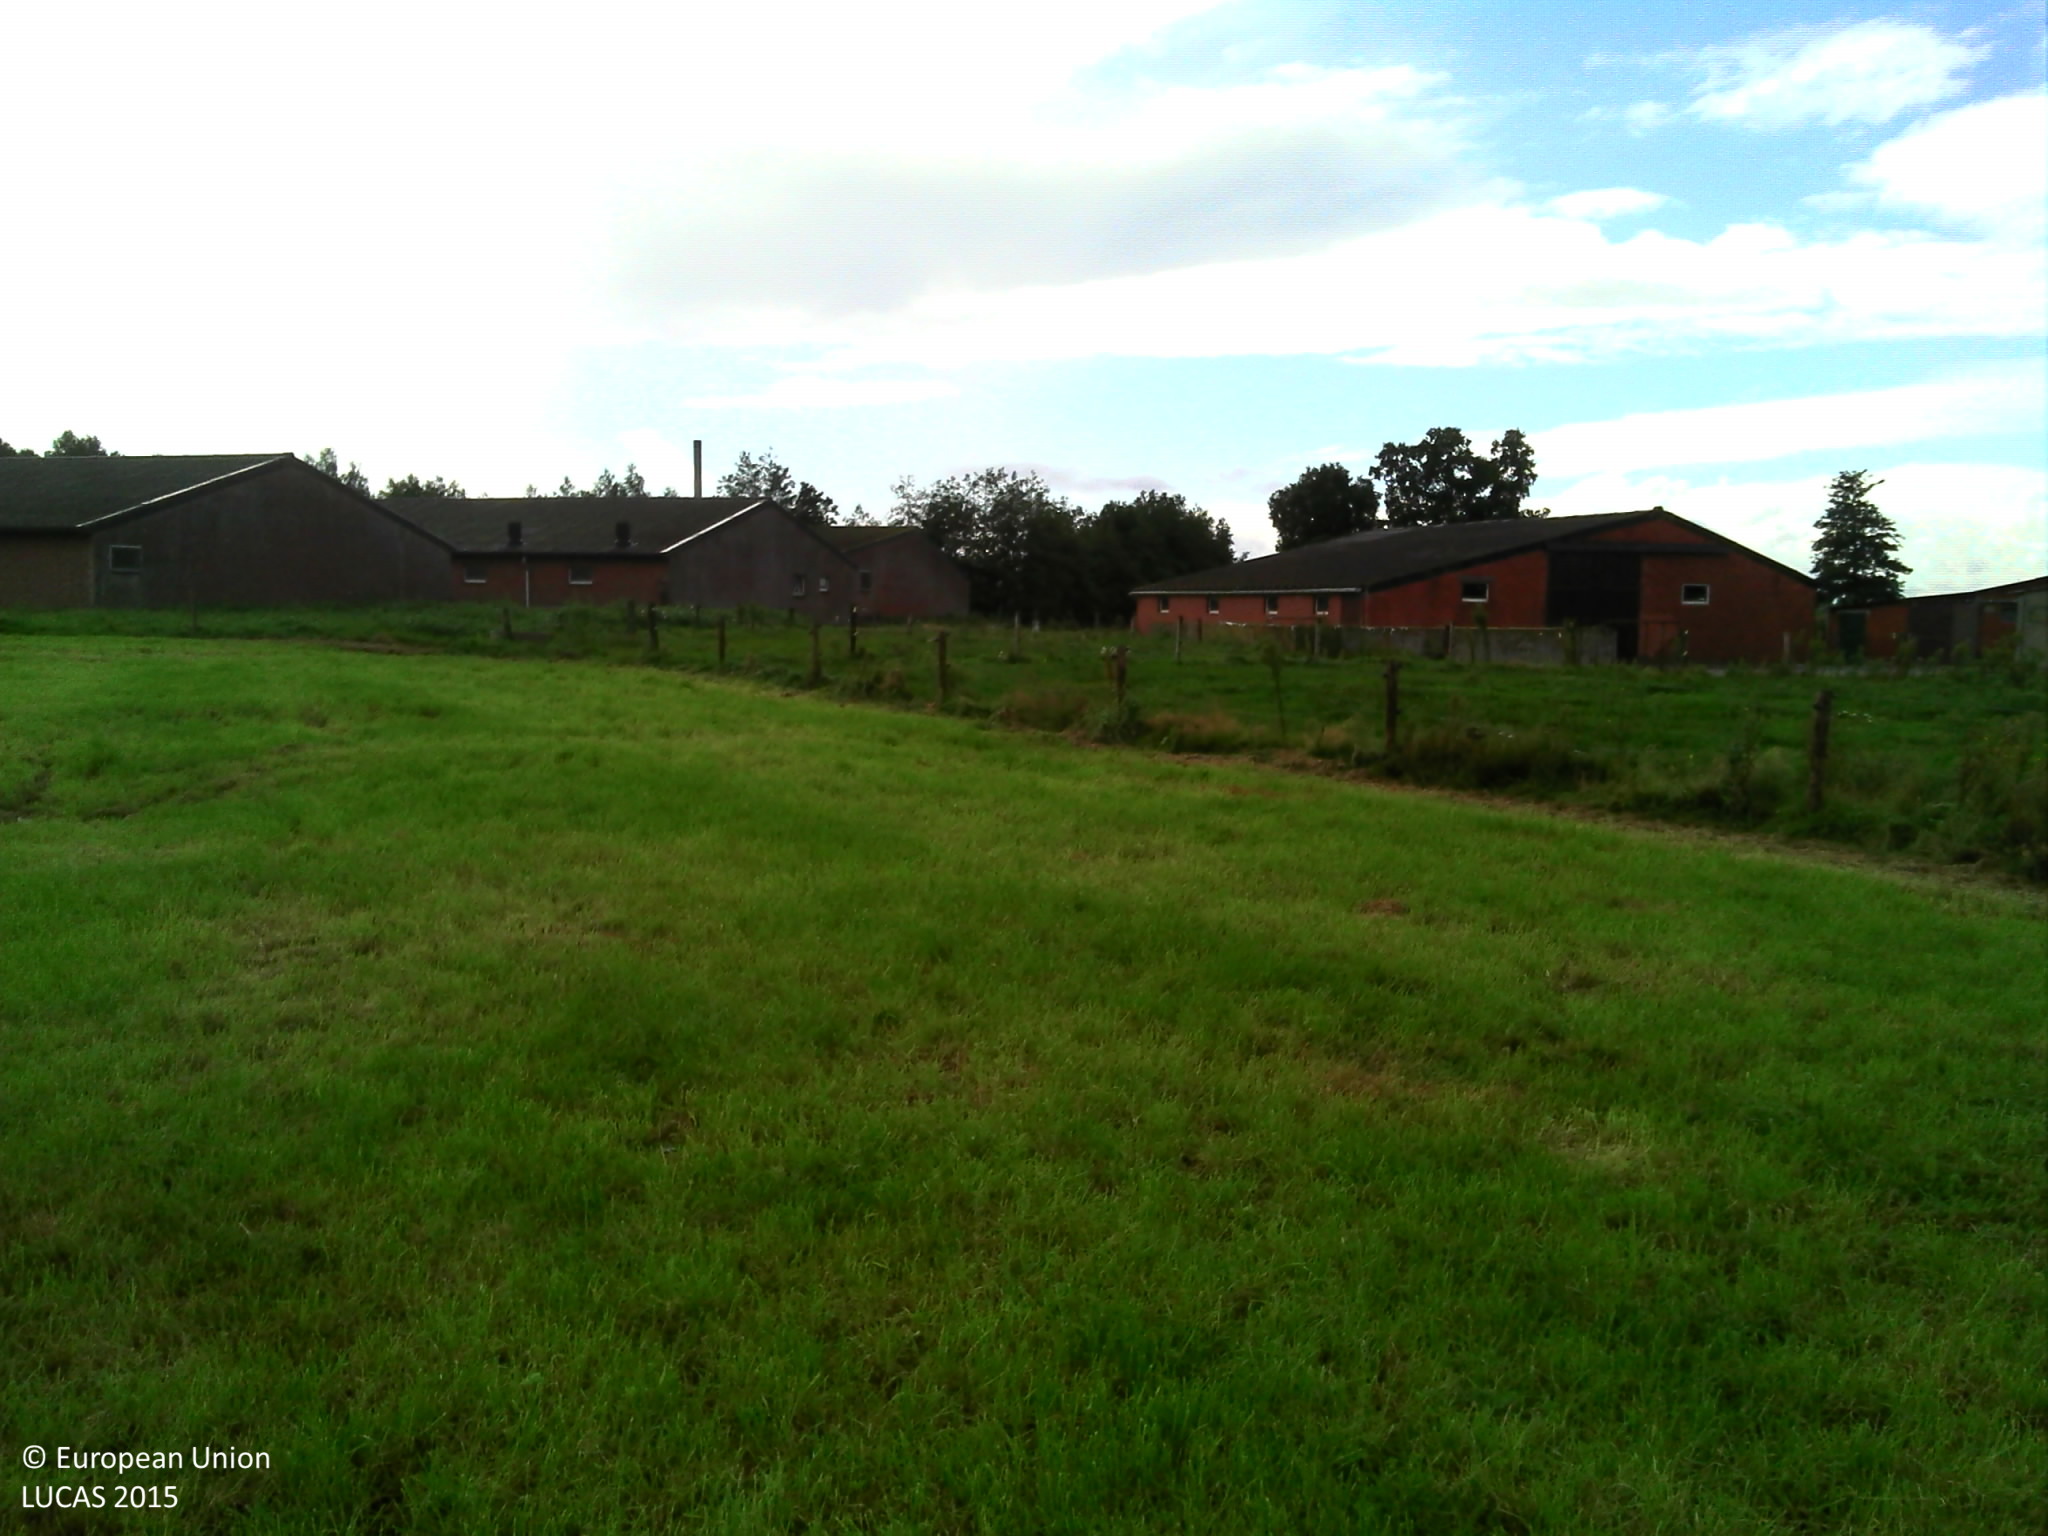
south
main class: Grassland
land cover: Grassland without tree/shrub cover
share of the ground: > 75 %
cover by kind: herbaceous plants 100 %
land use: Agriculture (excluding fallow land and kitchen gardens)
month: September
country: BE
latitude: 51.4325
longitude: 4.7462
